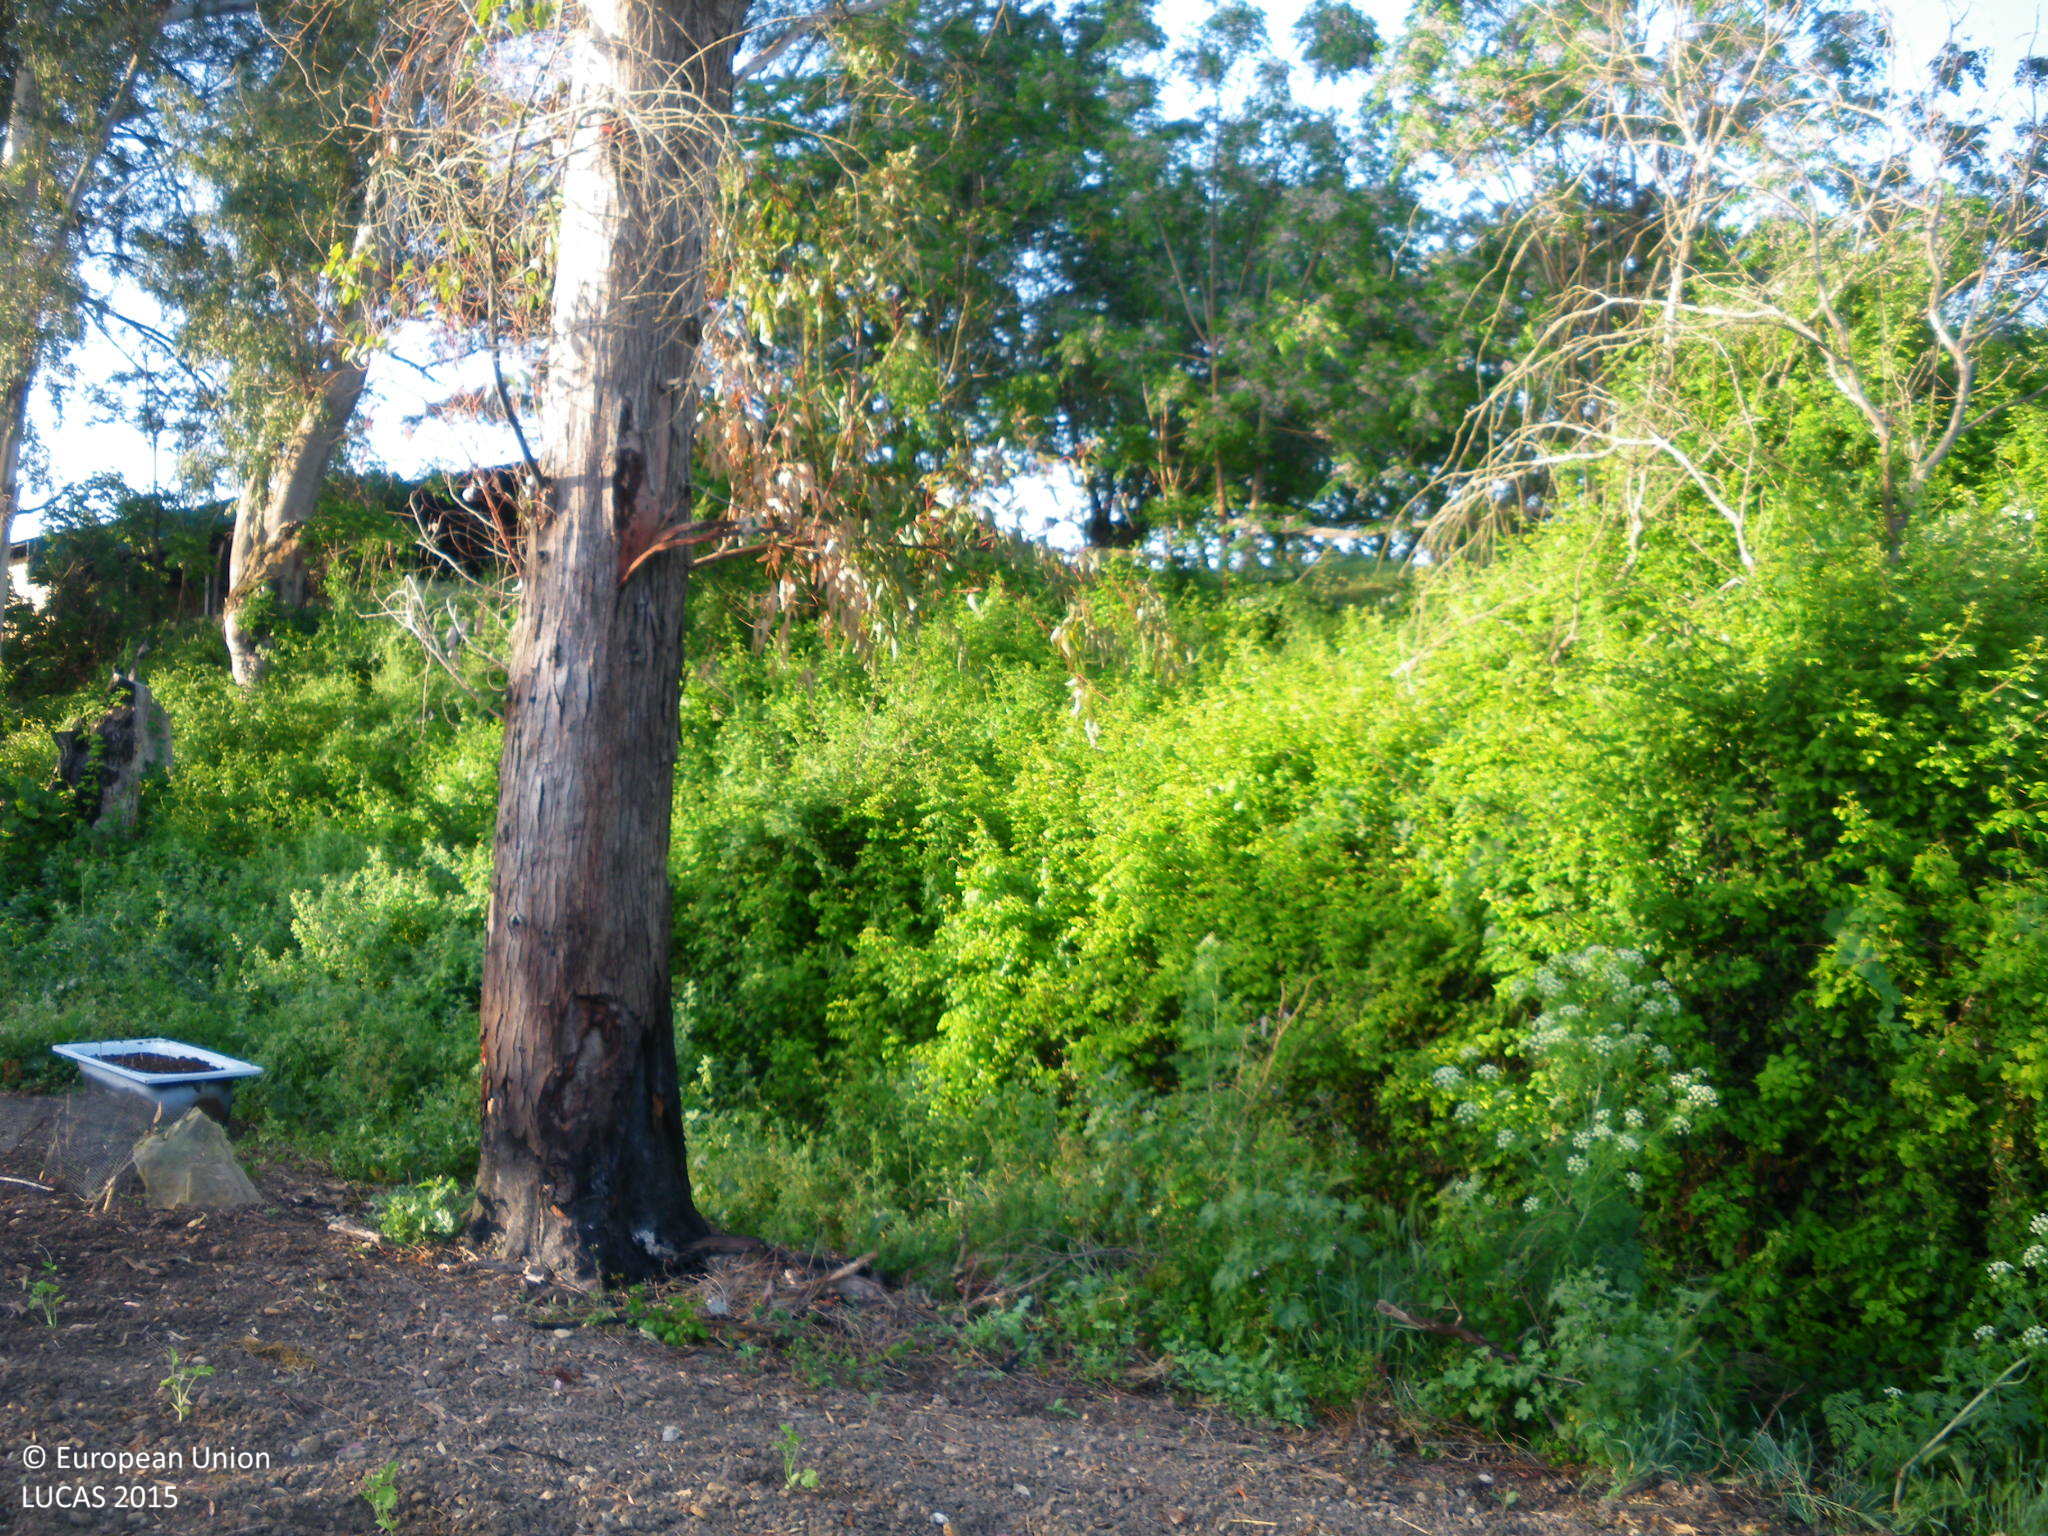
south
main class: Woodland
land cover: Broadleaved woodland
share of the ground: 25 - 50 %
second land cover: Other fresh vegetables
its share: < 10 %
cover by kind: unconsolidated bare surface 70 %, broadleaved forest trees 25 %, herbaceous plants 5 %
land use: Forestry
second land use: Agriculture (excluding fallow land and kitchen gardens)
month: April
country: ES
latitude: 36.6148
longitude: -5.9405
